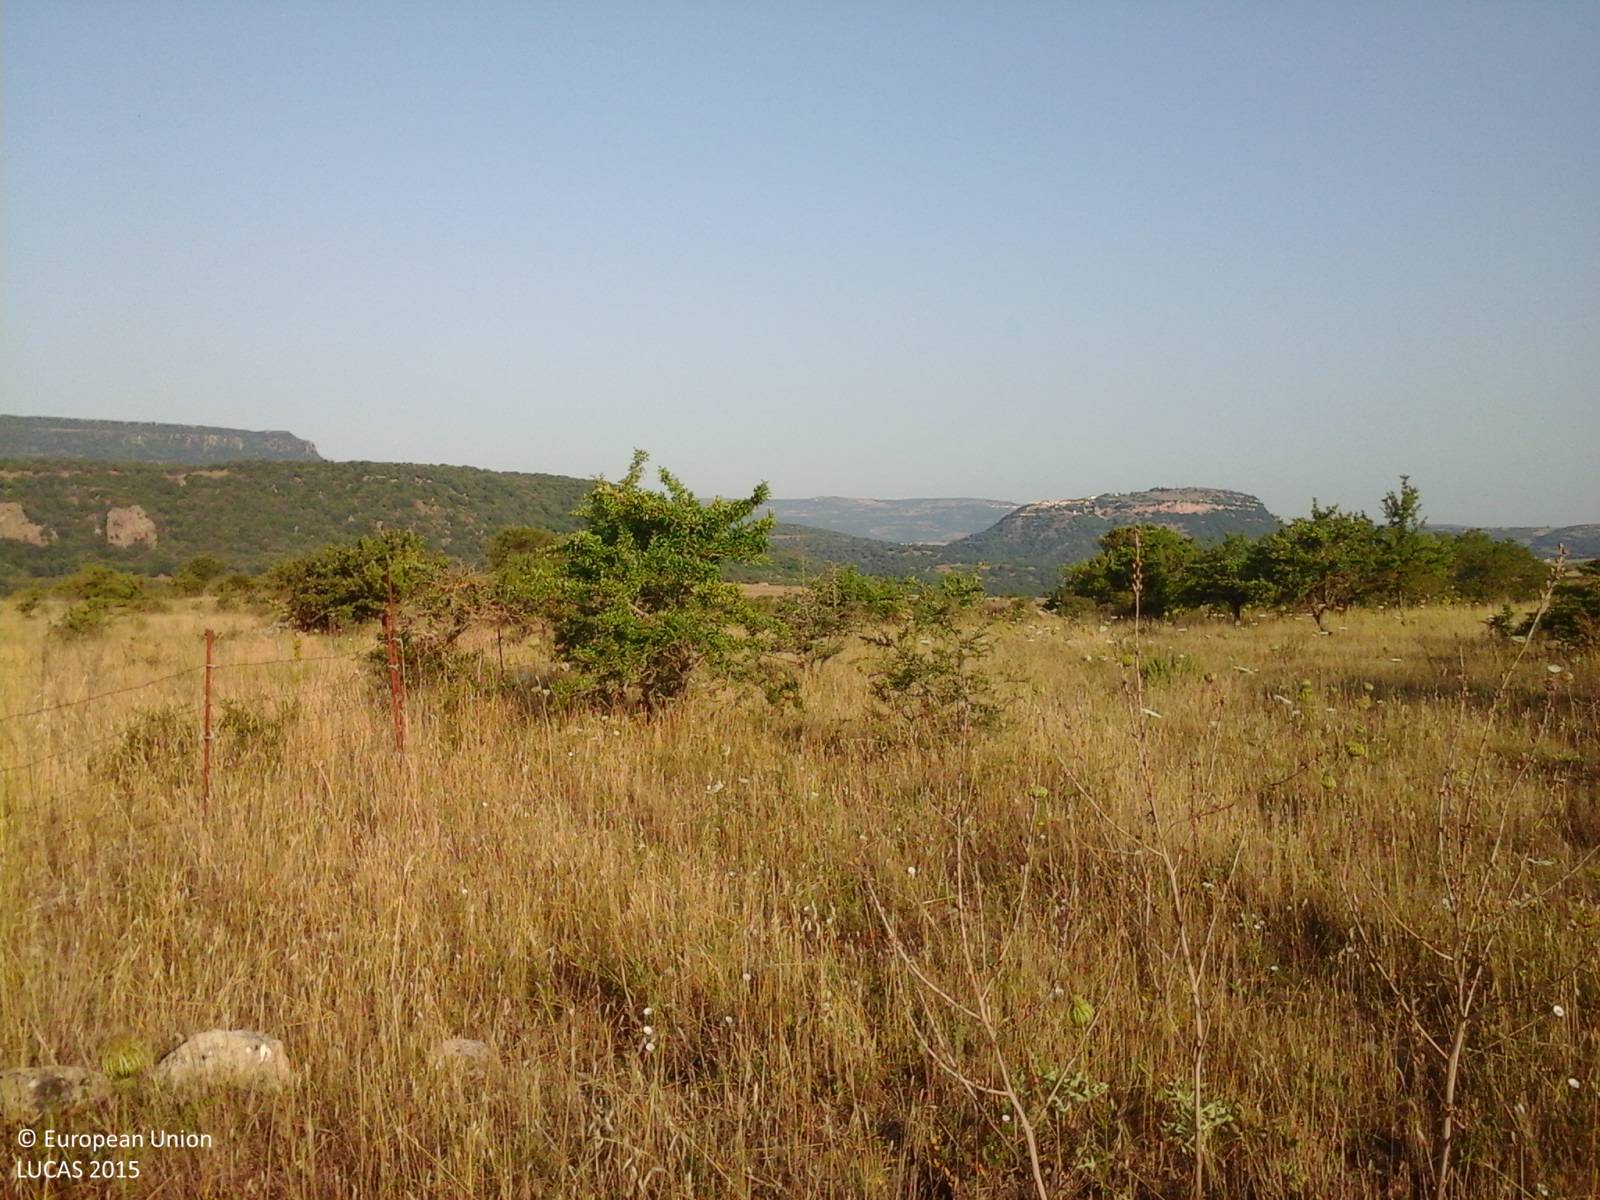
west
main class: Grassland
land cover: Grassland with sparse tree/shrub cover
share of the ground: > 75 %
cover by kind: herbaceous plants 90 %, broadleaved forest trees 5 %, shrubs 5 %
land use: Agriculture (excluding fallow land and kitchen gardens)
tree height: < 5 m
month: July
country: IT
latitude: 40.4565
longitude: 8.6038
